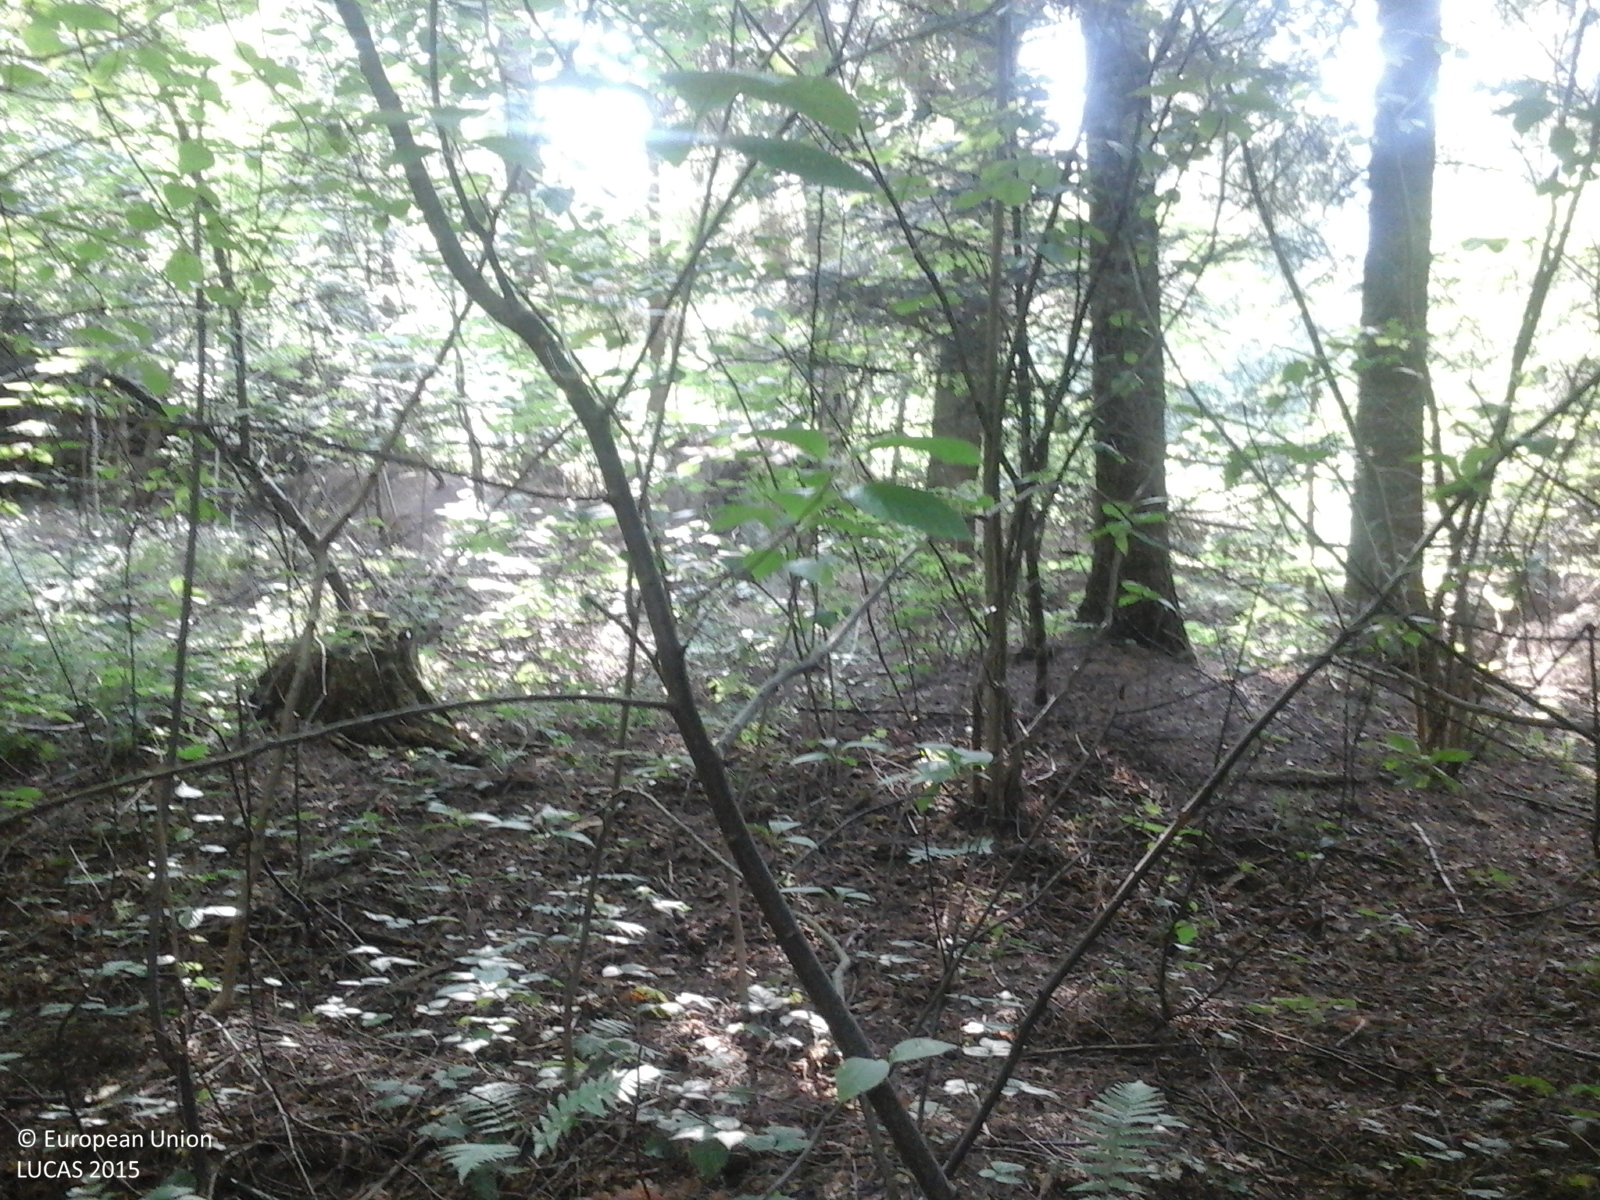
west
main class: Woodland
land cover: Spruce dominated mixed woodland
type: alpine coniferous forest
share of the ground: > 75 %
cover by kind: coniferous forest trees 75 %, broadleaved forest trees 25 %
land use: Forestry
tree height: > 5 m
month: June
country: RO
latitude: 47.6929
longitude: 25.8347
